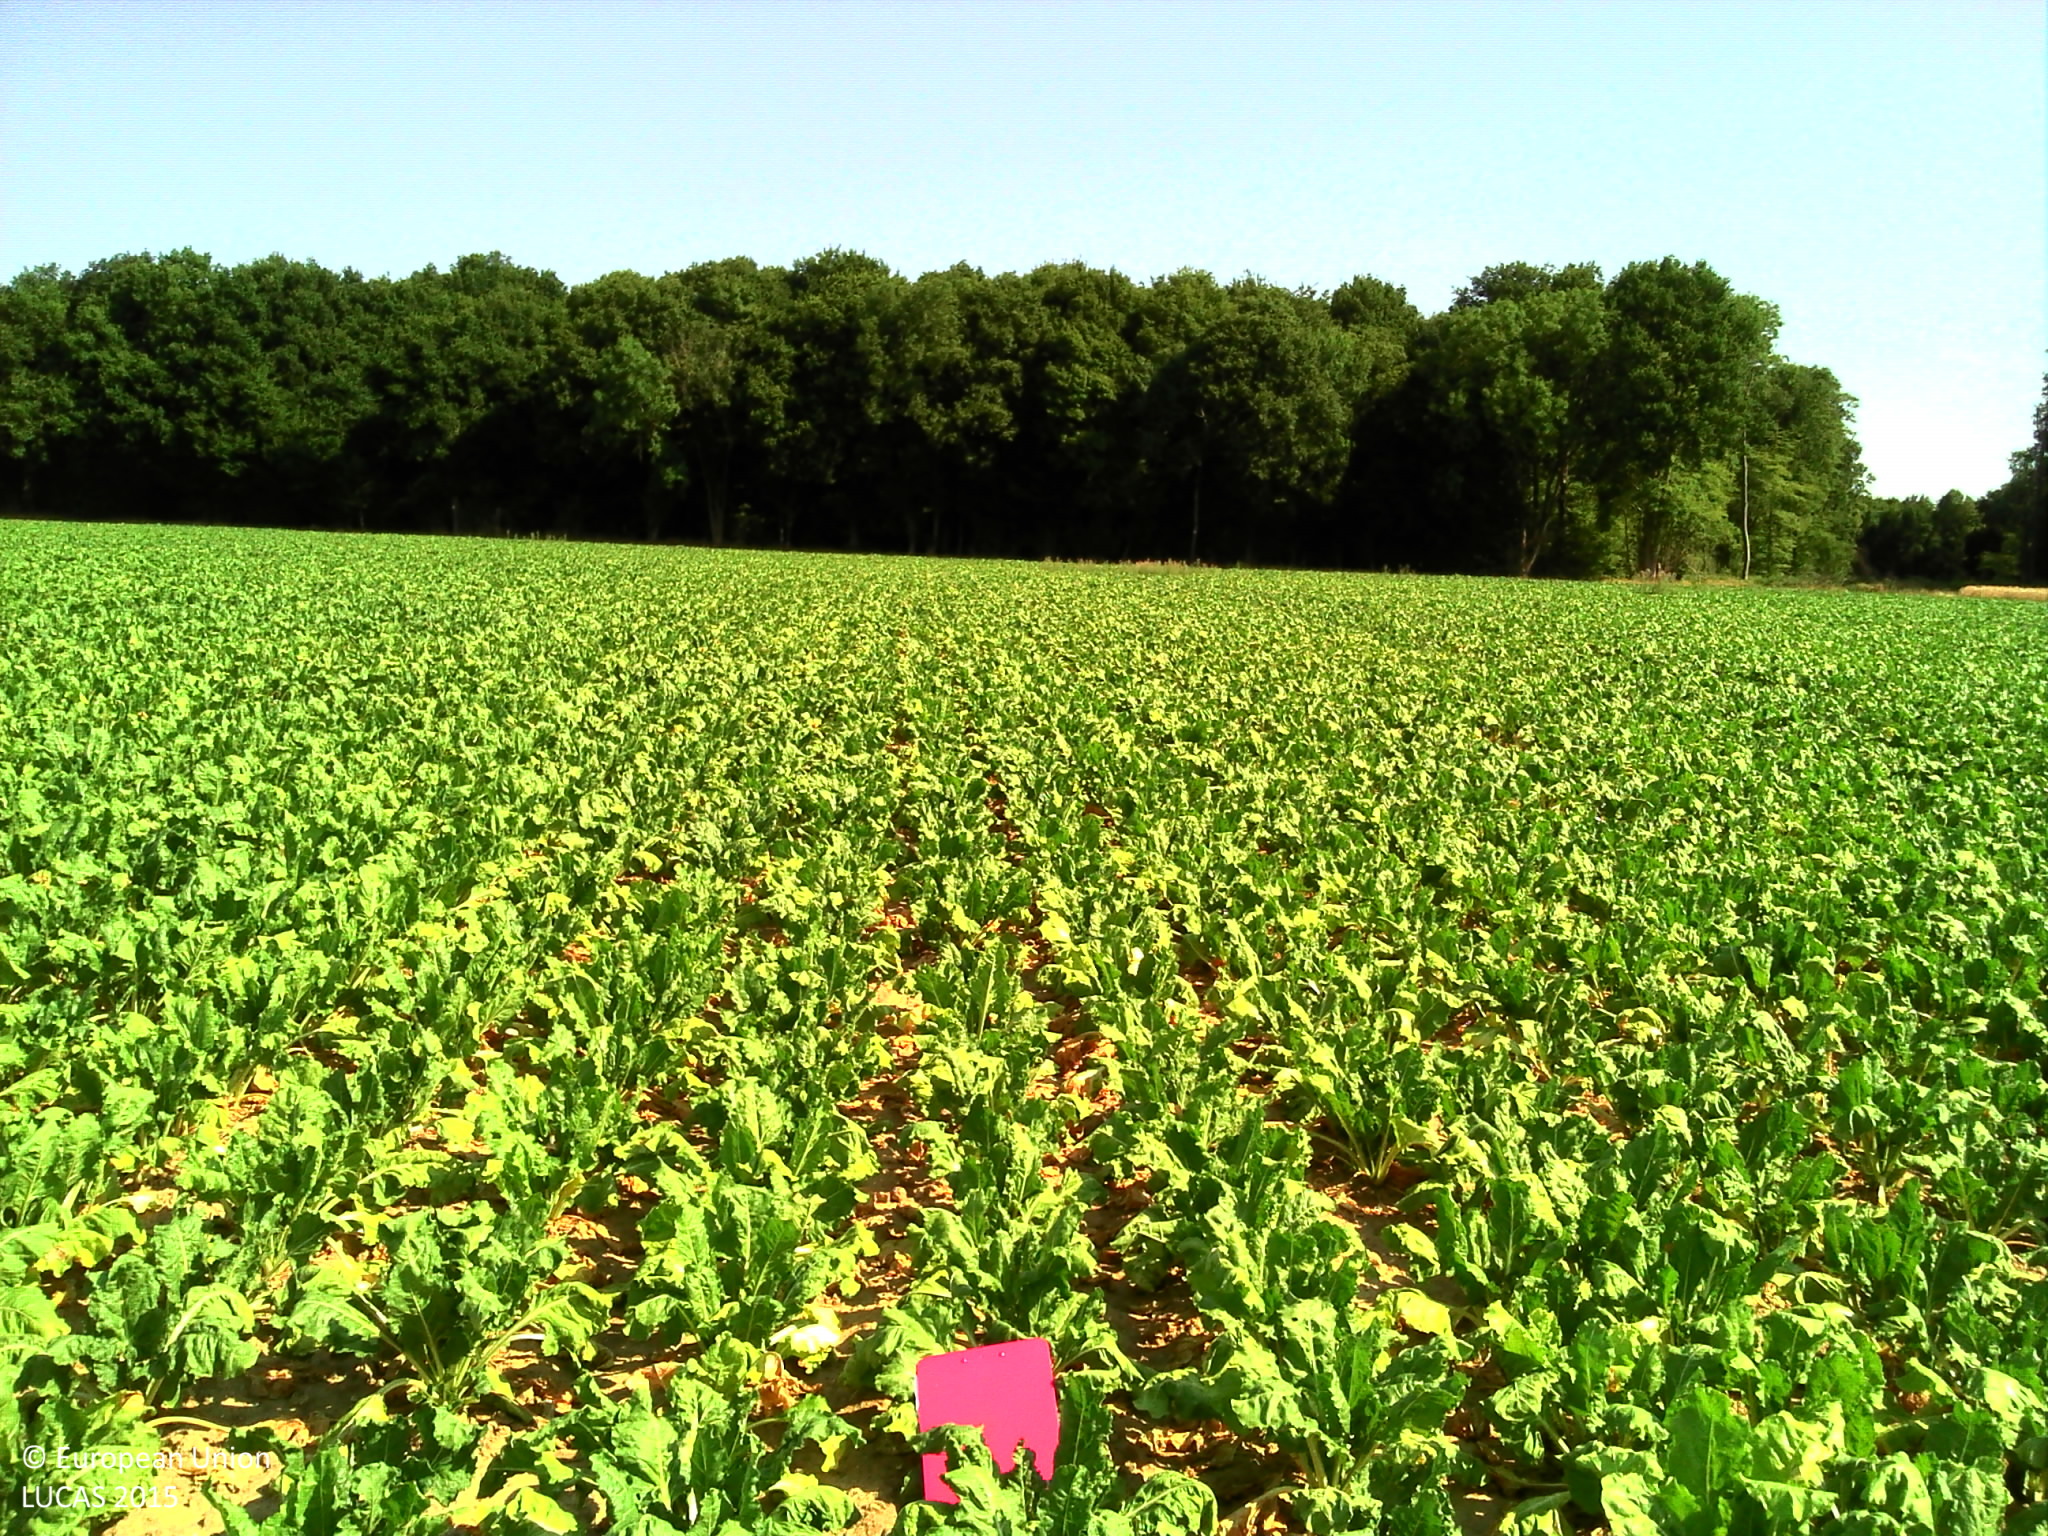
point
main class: Cropland
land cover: Sugar beet
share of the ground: > 75 %
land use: Agriculture (excluding fallow land and kitchen gardens)
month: July
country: FR
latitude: 49.2538
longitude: 2.2794
